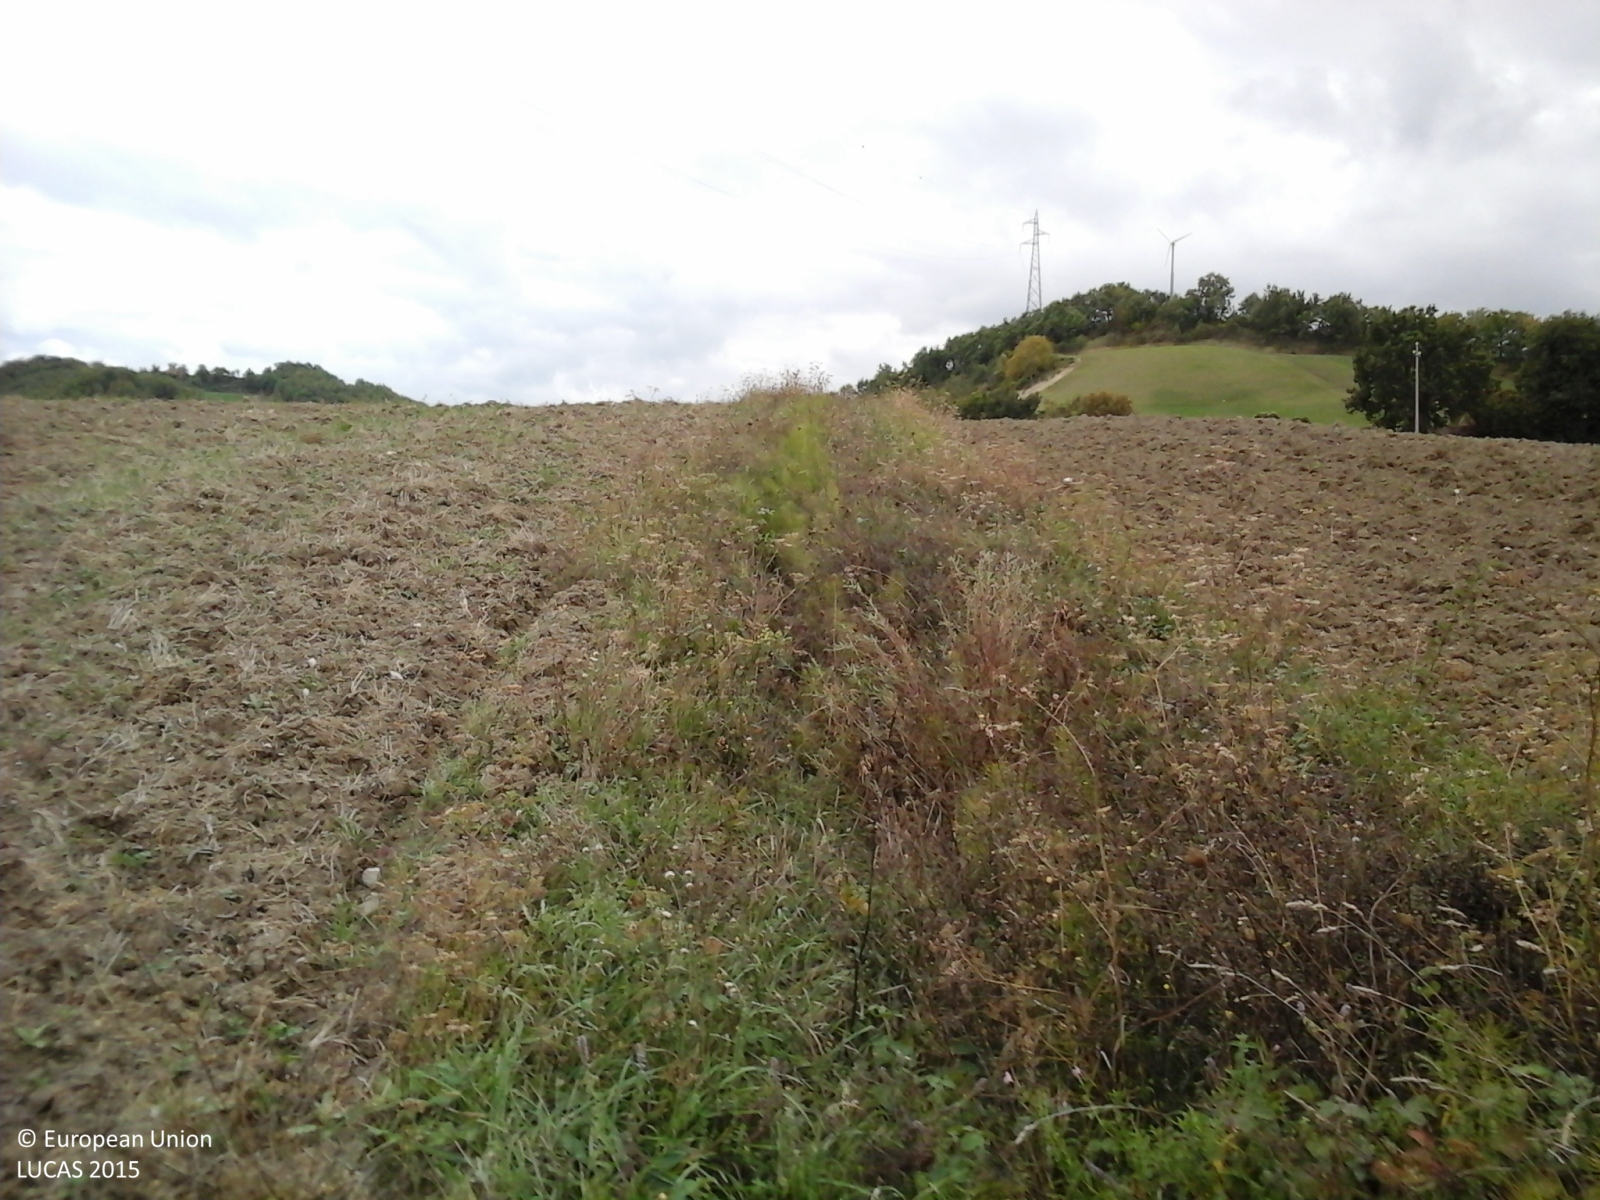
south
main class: Grassland
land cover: Spontaneously vegetated surfaces
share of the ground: < 10 %
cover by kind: unconsolidated bare surface 80 %, herbaceous plants 20 %
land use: Agriculture (excluding fallow land and kitchen gardens)
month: September
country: IT
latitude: 43.4811
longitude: 12.8487
